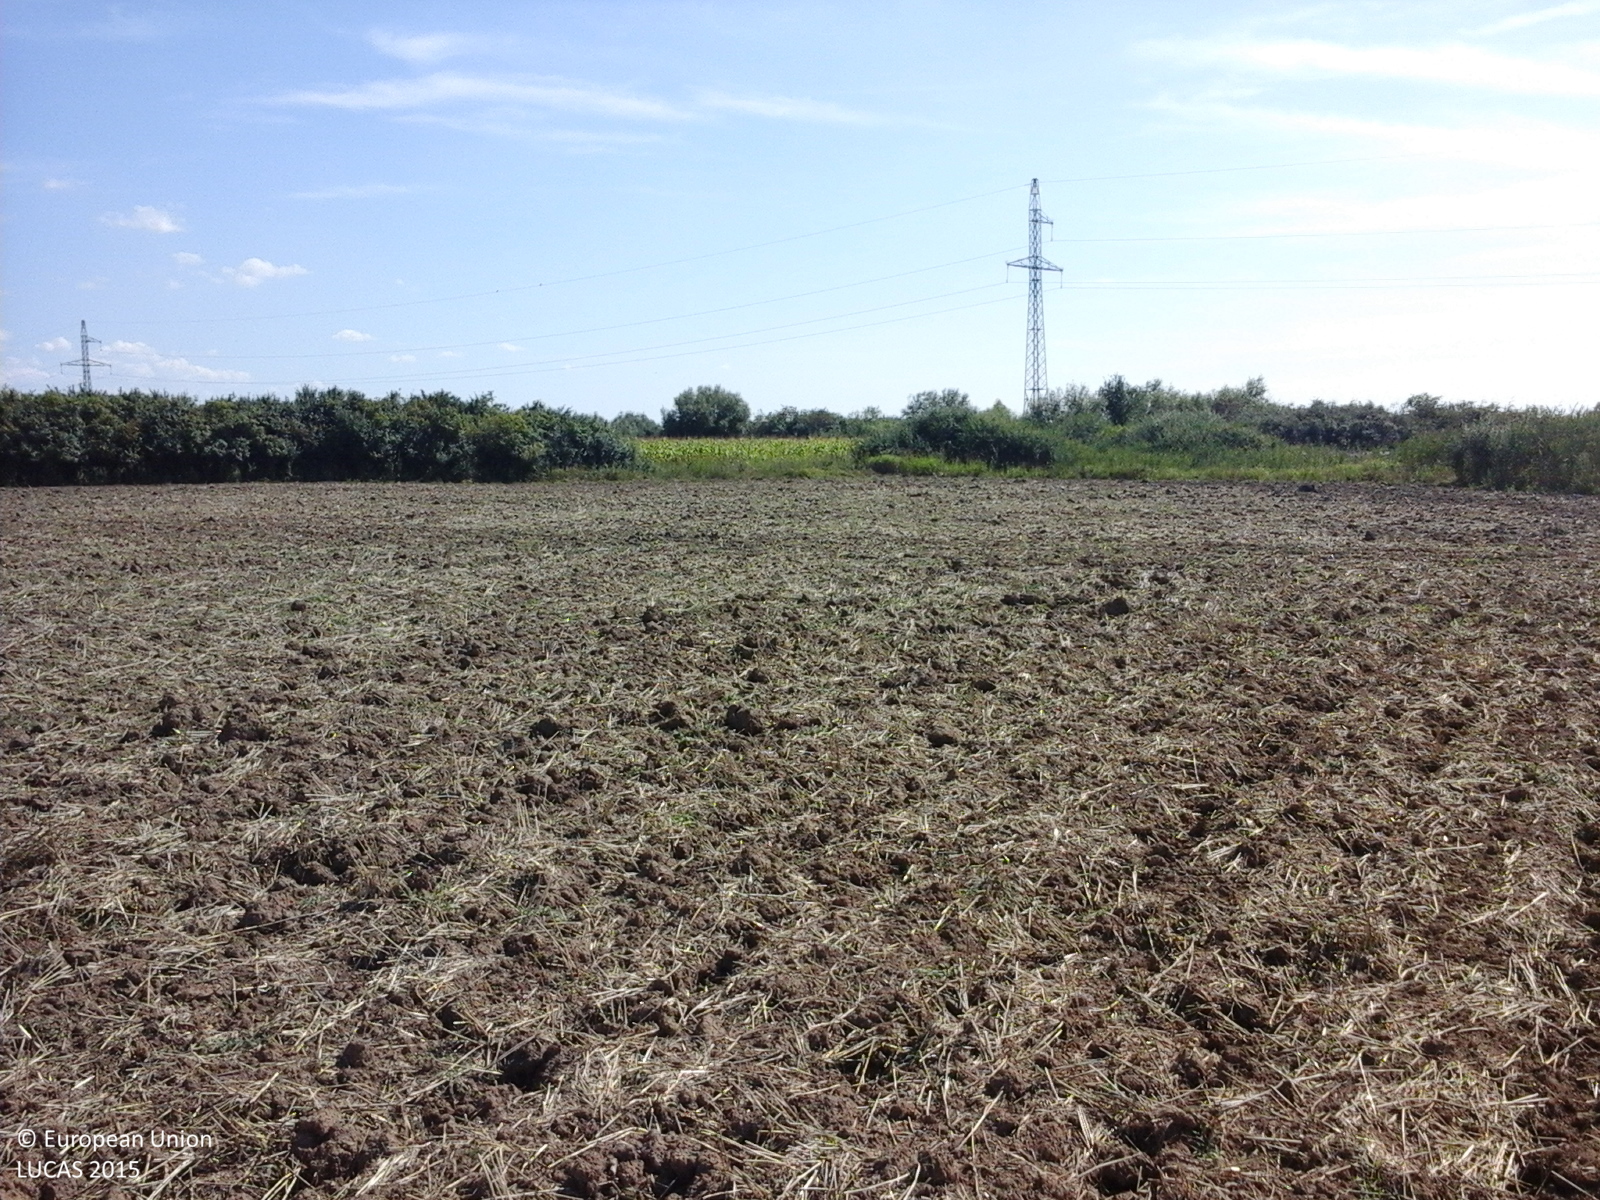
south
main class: Cropland
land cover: Common wheat
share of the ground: 25 - 50 %
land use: Agriculture (excluding fallow land and kitchen gardens)
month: August
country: RO
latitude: 45.7332
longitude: 21.1195
